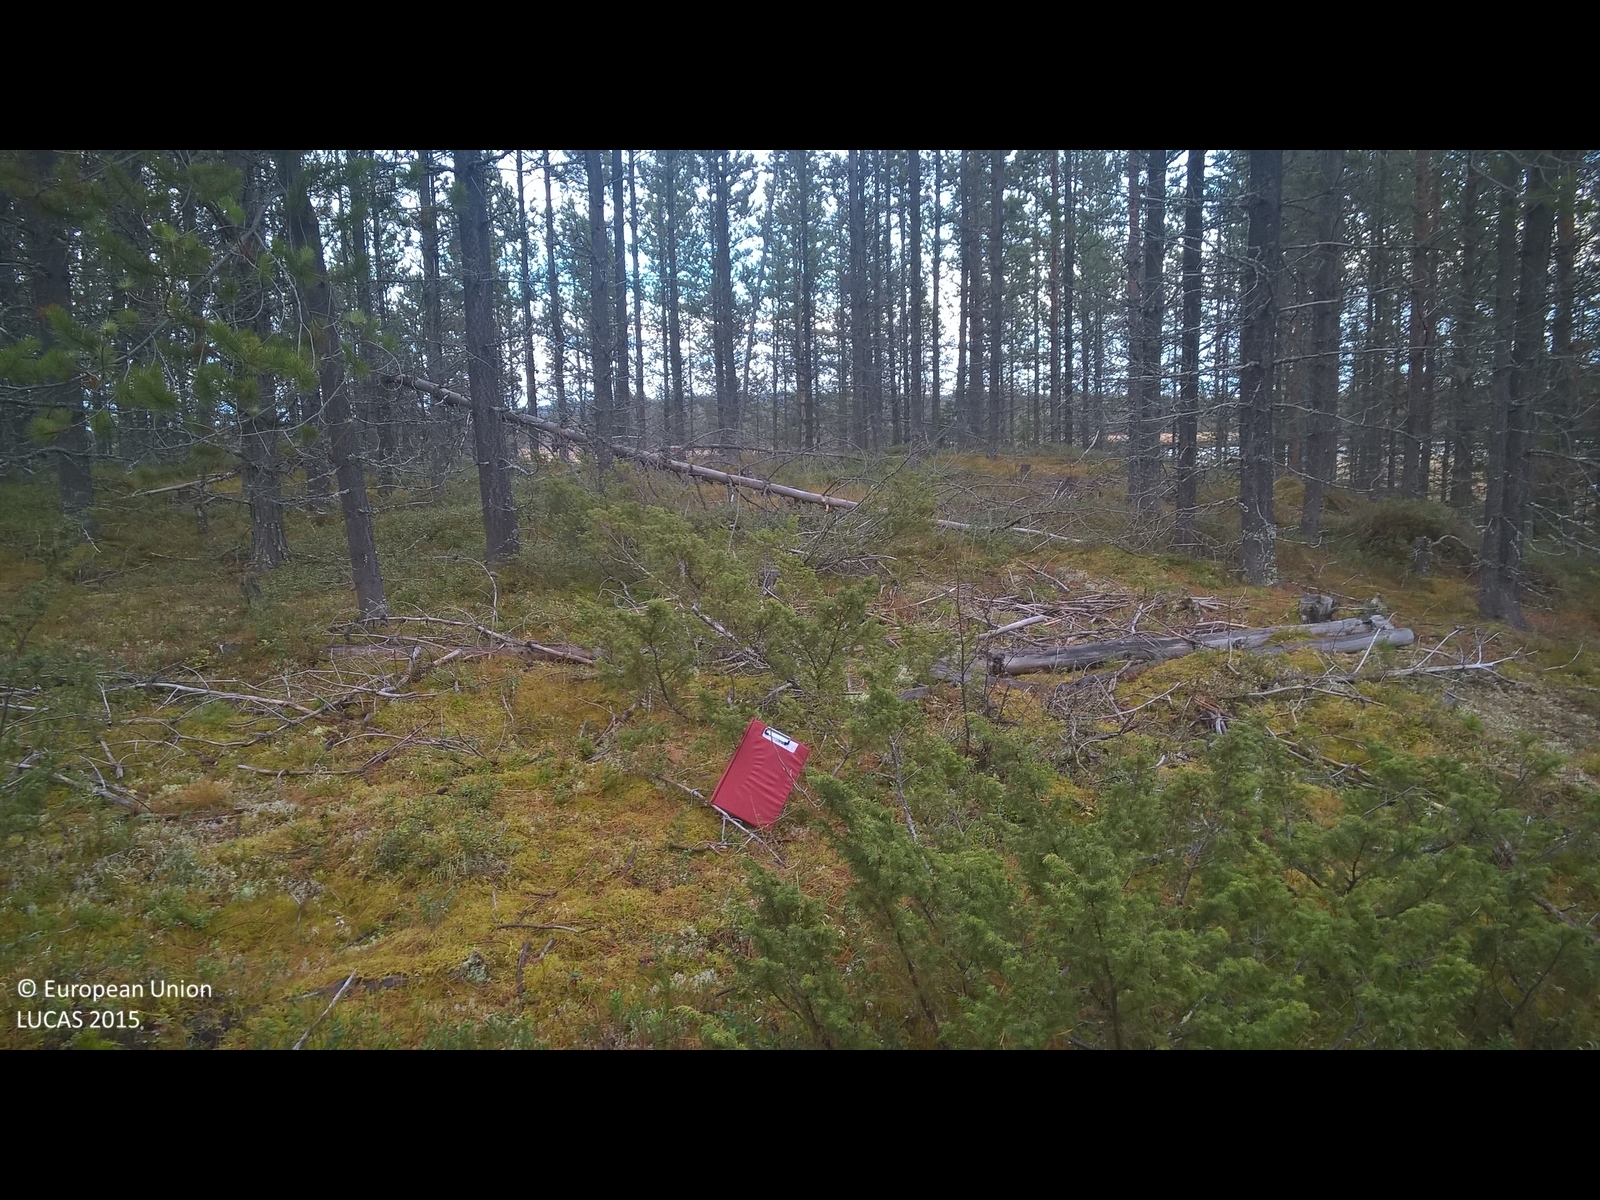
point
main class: Shrubland
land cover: Shrubland without tree cover
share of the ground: > 75 %
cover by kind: shrubs 50 %, herbaceous plants 50 %
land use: Electricity, gas and thermal power distribution
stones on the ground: < 10 %
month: October
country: SE
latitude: 65.2011
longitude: 17.8893
